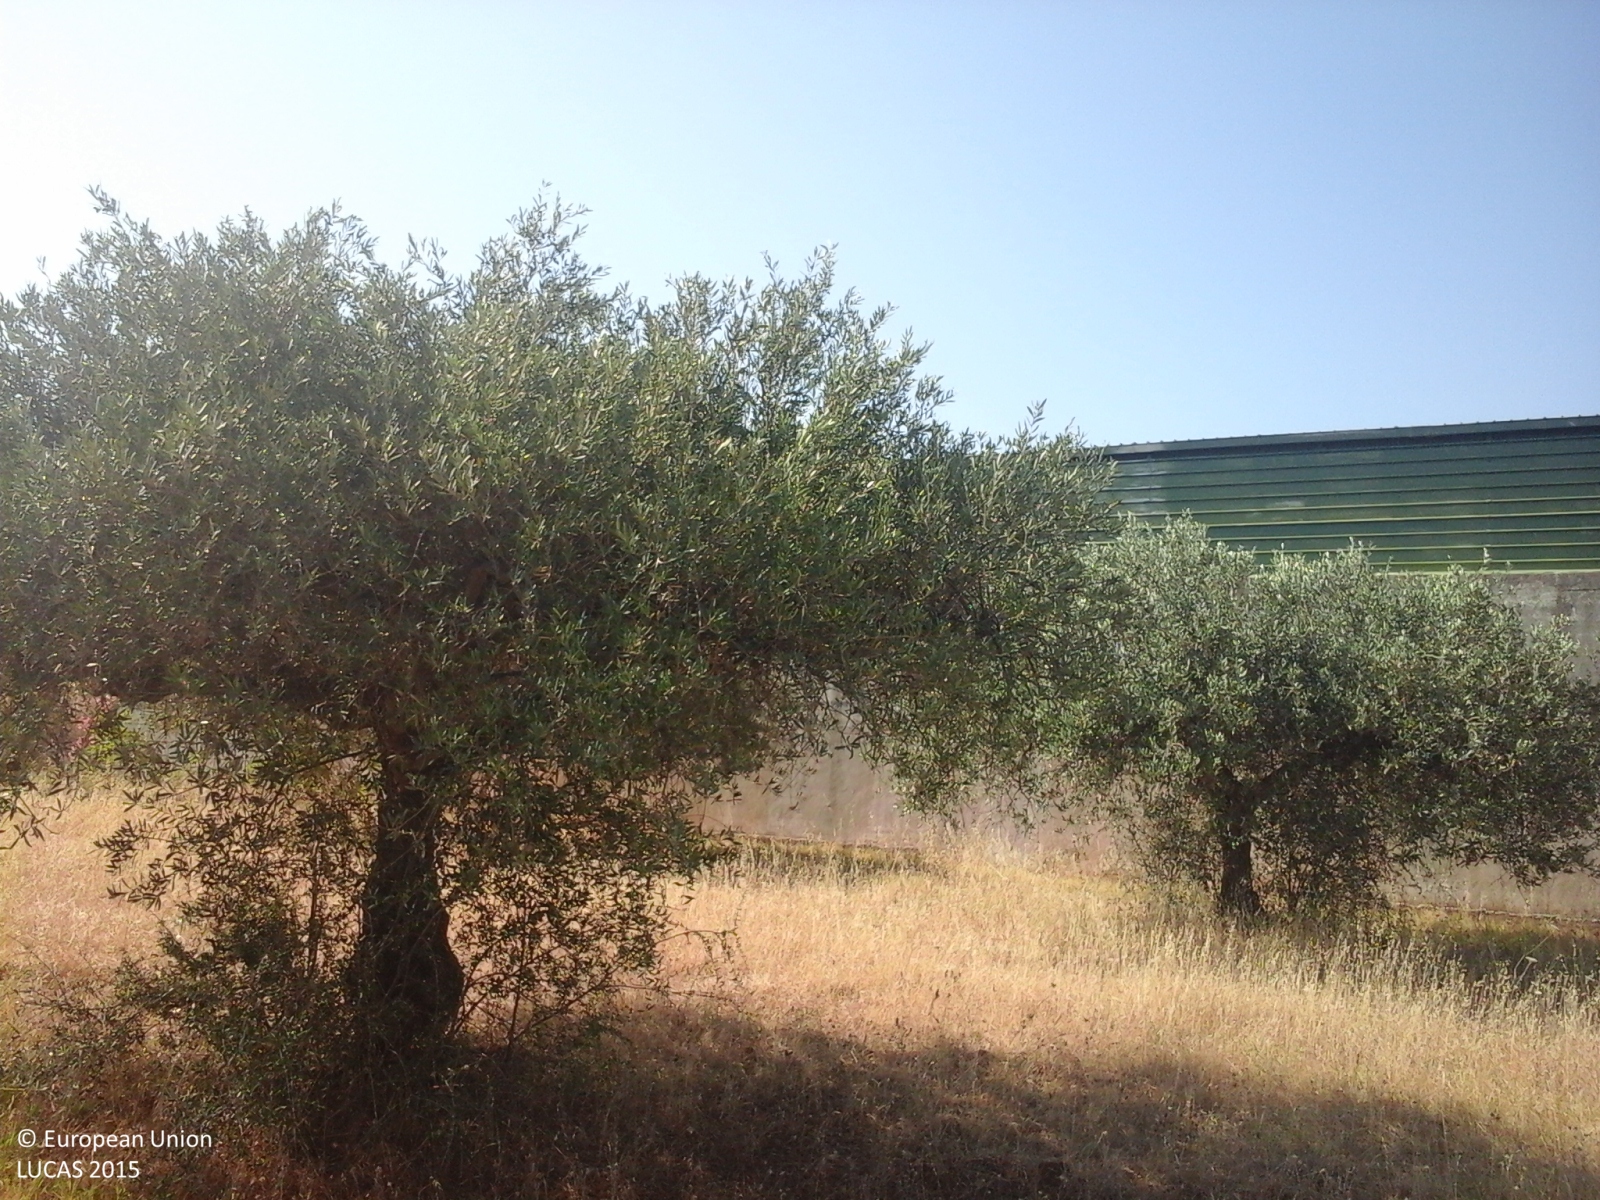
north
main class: Cropland
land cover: Olive groves
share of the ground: 25 - 50 %
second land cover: Spontaneously vegetated surfaces
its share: > 75 %
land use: Agriculture (excluding fallow land and kitchen gardens)
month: May
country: IT
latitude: 37.6282
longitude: 12.9801
